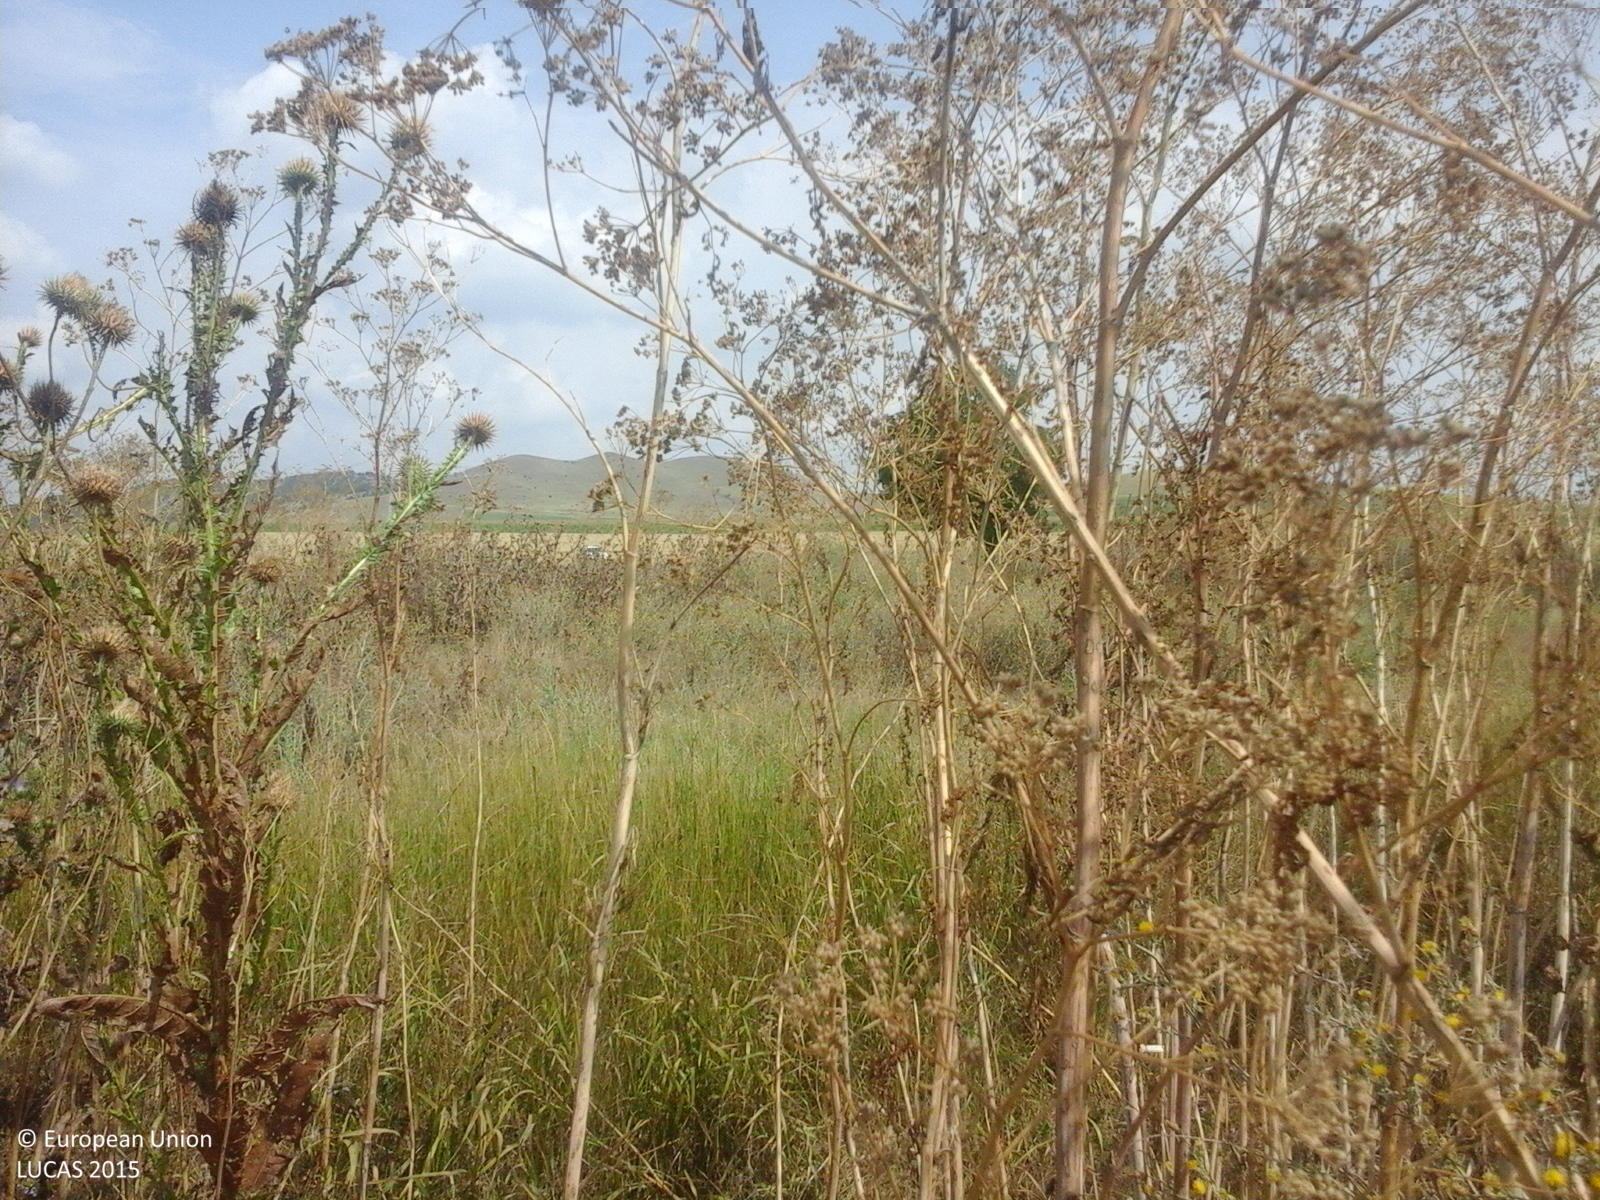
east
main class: Grassland
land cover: Spontaneously vegetated surfaces
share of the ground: > 75 %
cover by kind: herbaceous plants 100 %
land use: Semi-natural and natural areas not in use
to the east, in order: Spontaneously vegetated surfaces; Common wheat; Other bare soil; Grass margins; Tracks; Grass margins; Common wheat
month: July
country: RO
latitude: 44.9730
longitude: 28.3183
